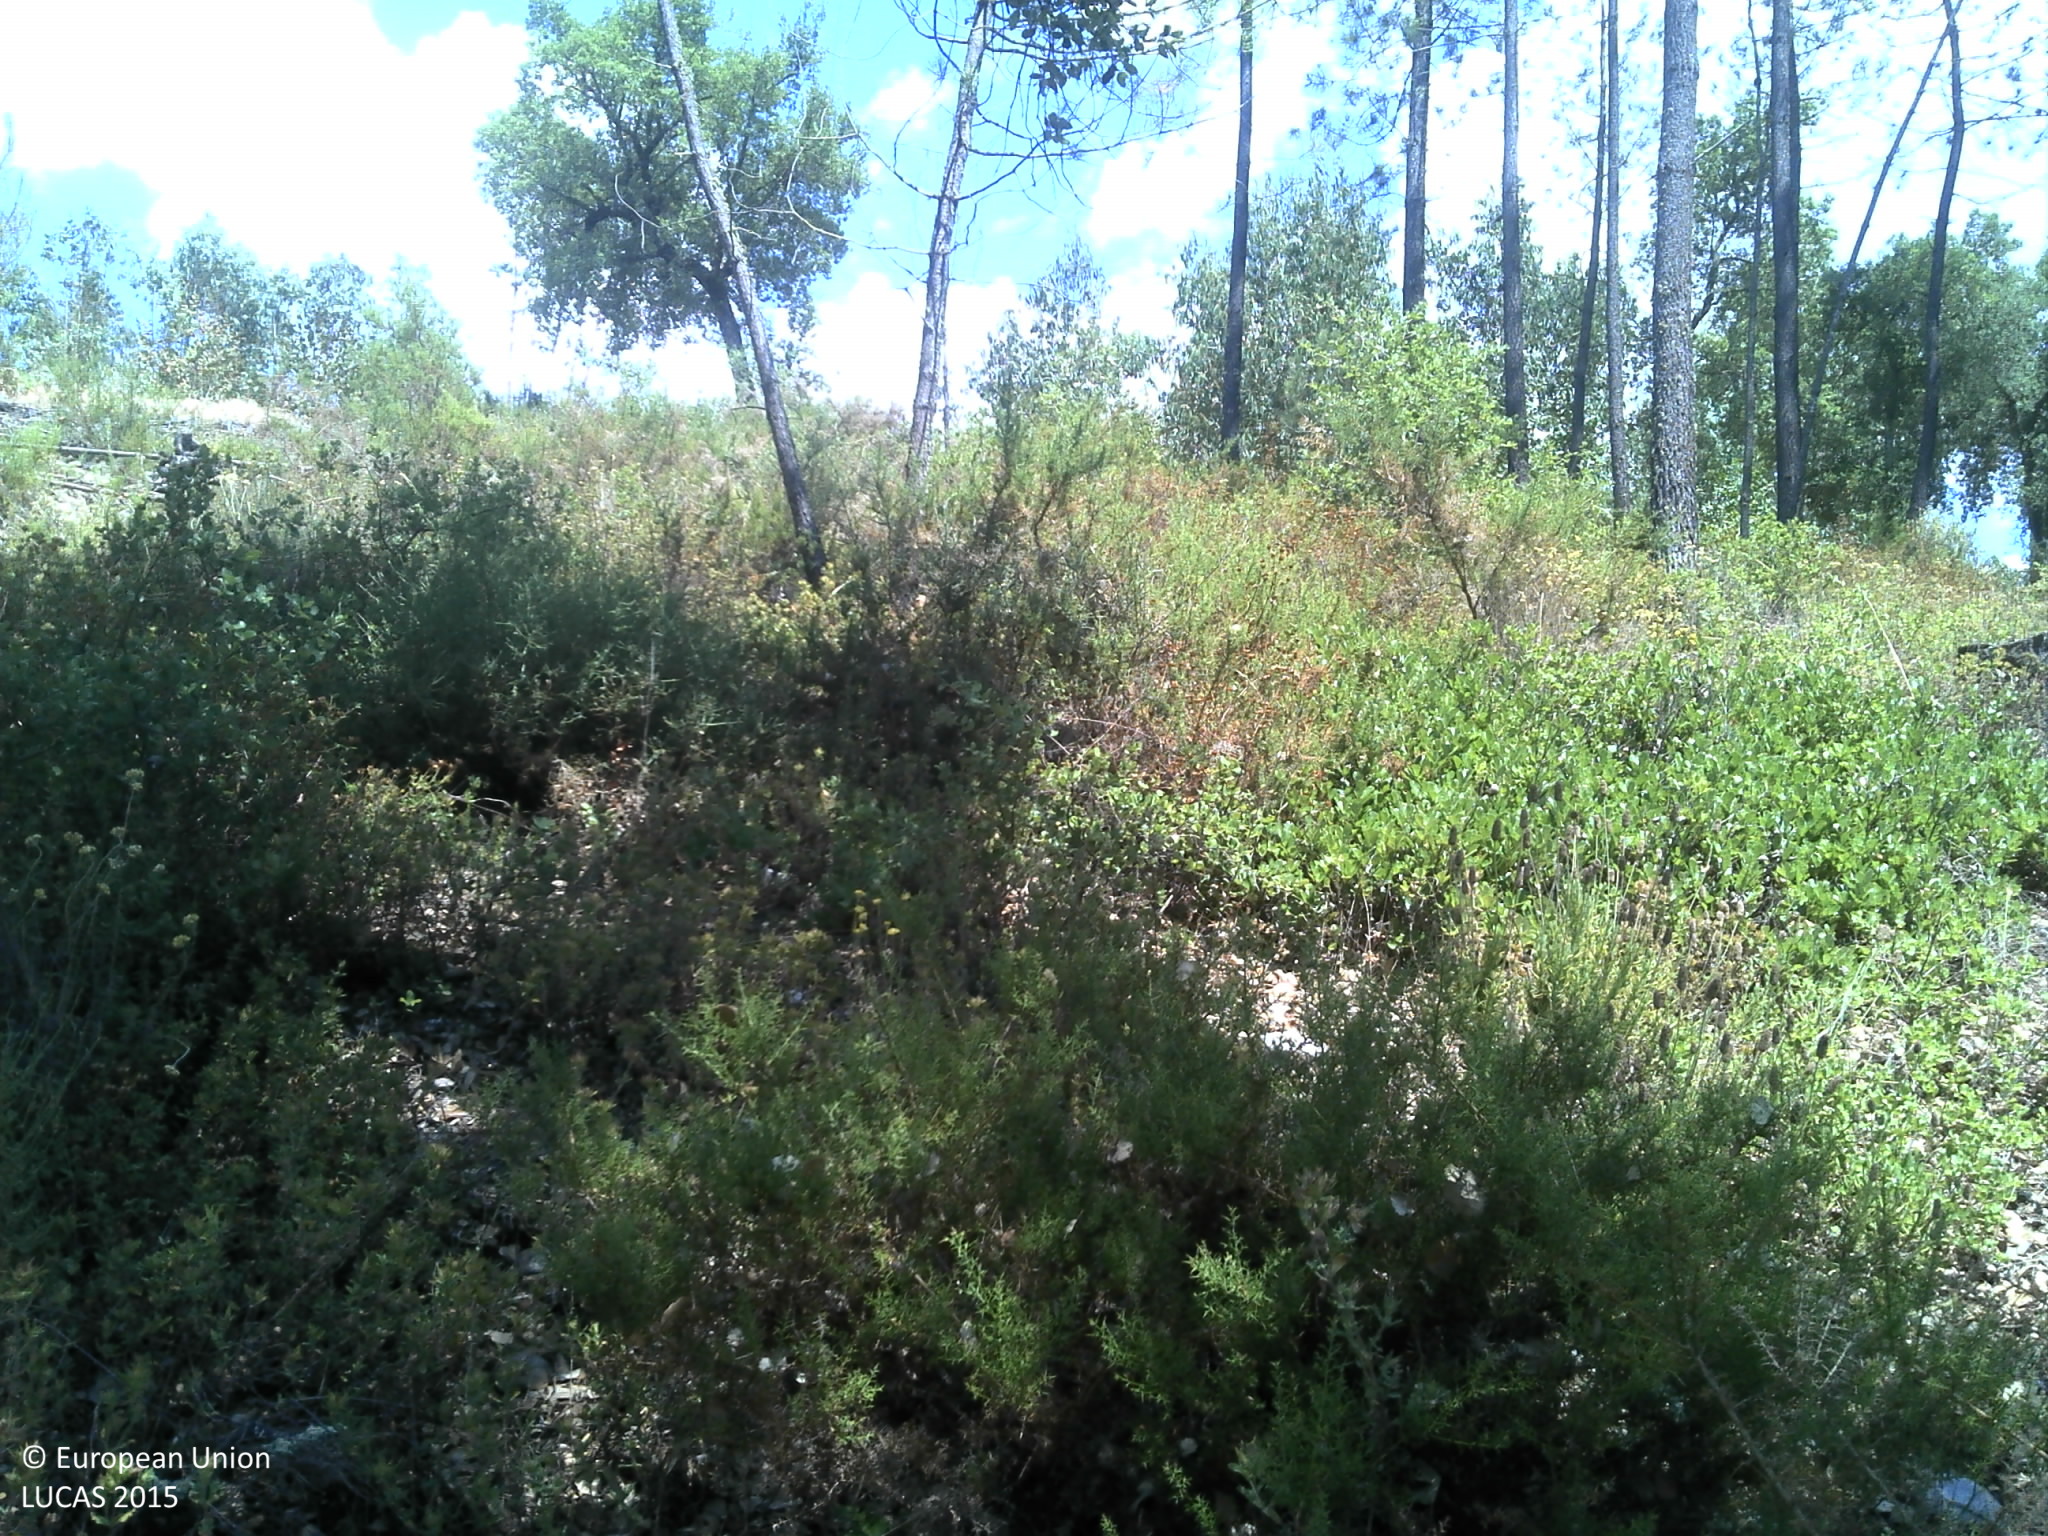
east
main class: Woodland
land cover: Broadleaved woodland
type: broadleaved evergreen forest
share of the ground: 25 - 50 %
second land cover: Grassland without tree/shrub cover
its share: 25 - 50 %
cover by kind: broadleaved forest trees 50 %, unconsolidated bare surface 20 %, shrubs 15 %, herbaceous plants 15 %
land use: Forestry
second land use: Agriculture (excluding fallow land and kitchen gardens)
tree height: > 5 m
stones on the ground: 10 - 25 %
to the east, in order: Broadleaved woodland; Grassland without tree/shrub cover; Electric lines; Broadleaved woodland; Tracks; Shrubland with sparse tree cover; Broadleaved woodland; Tracks; Broadleaved woodland; Tracks; Broadleaved woodland; Tracks; Broadleaved woodland
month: June
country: PT
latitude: 39.2832
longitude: -8.2274
